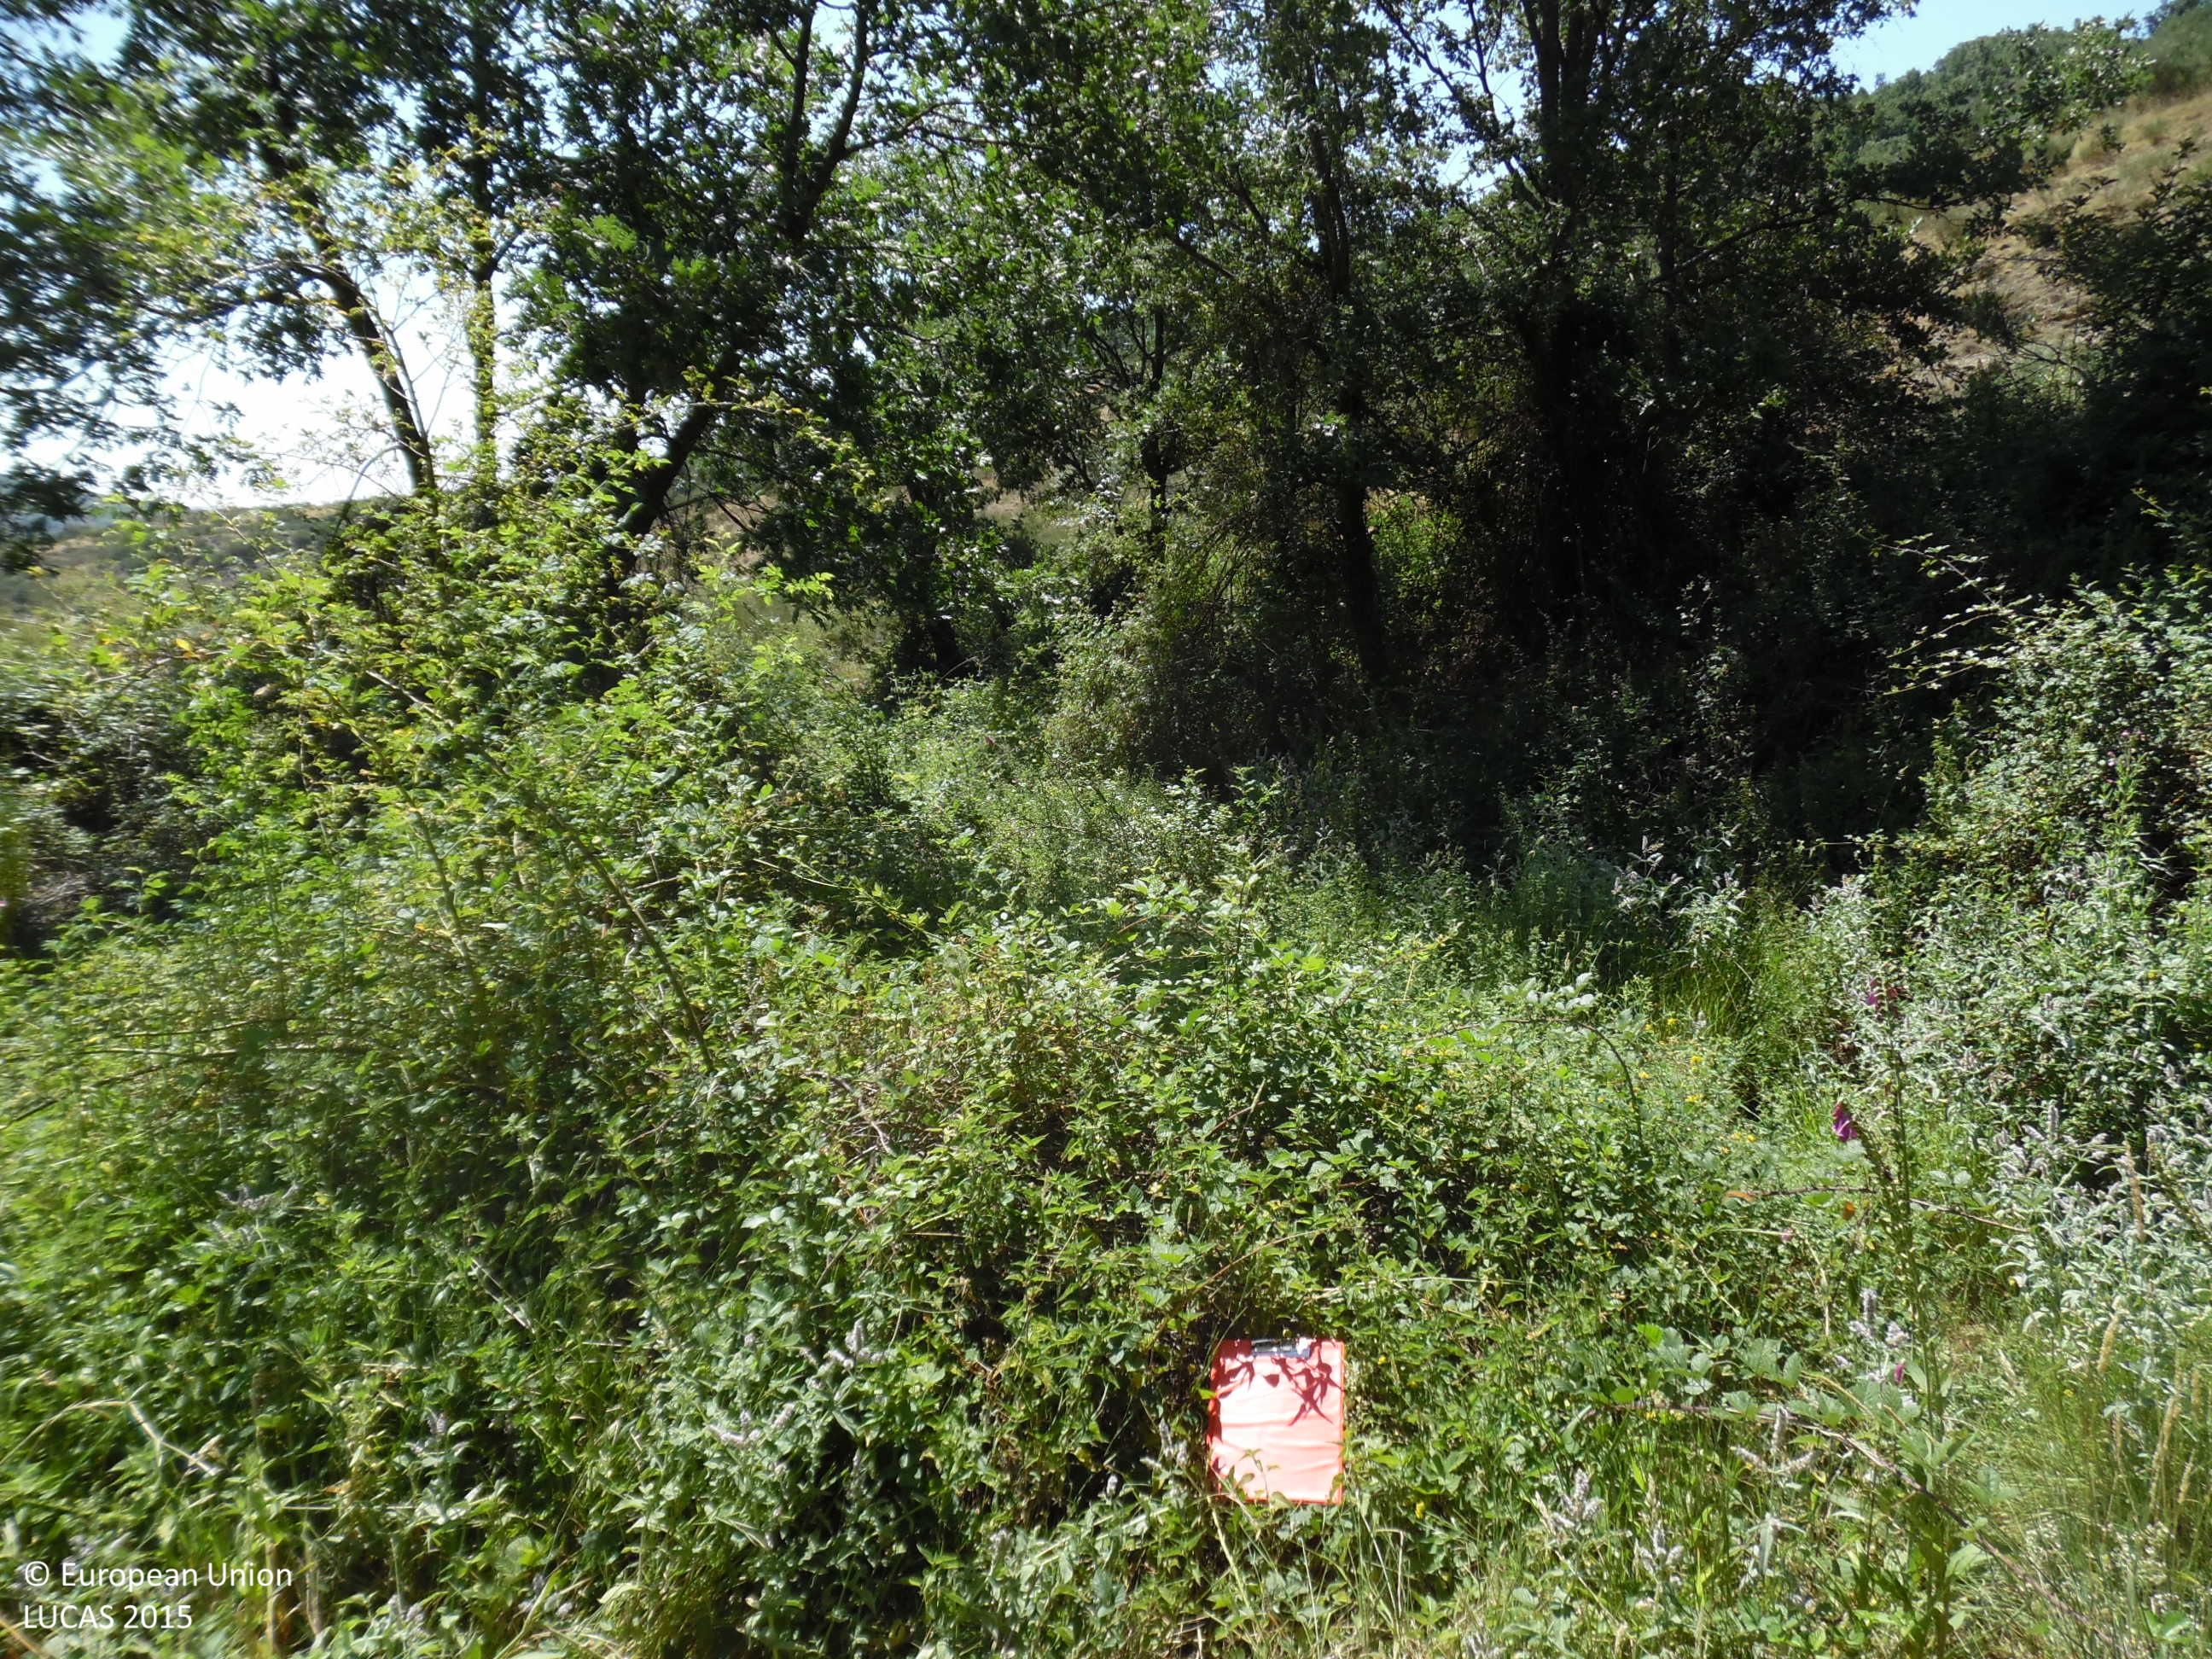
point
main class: Shrubland
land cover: Shrubland with sparse tree cover
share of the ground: > 75 %
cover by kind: shrubs 95 %, broadleaved forest trees 5 %
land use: Abandoned areas
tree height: > 5 m
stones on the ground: 10 - 25 %
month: July
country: ES
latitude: 42.8117
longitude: -5.8450
